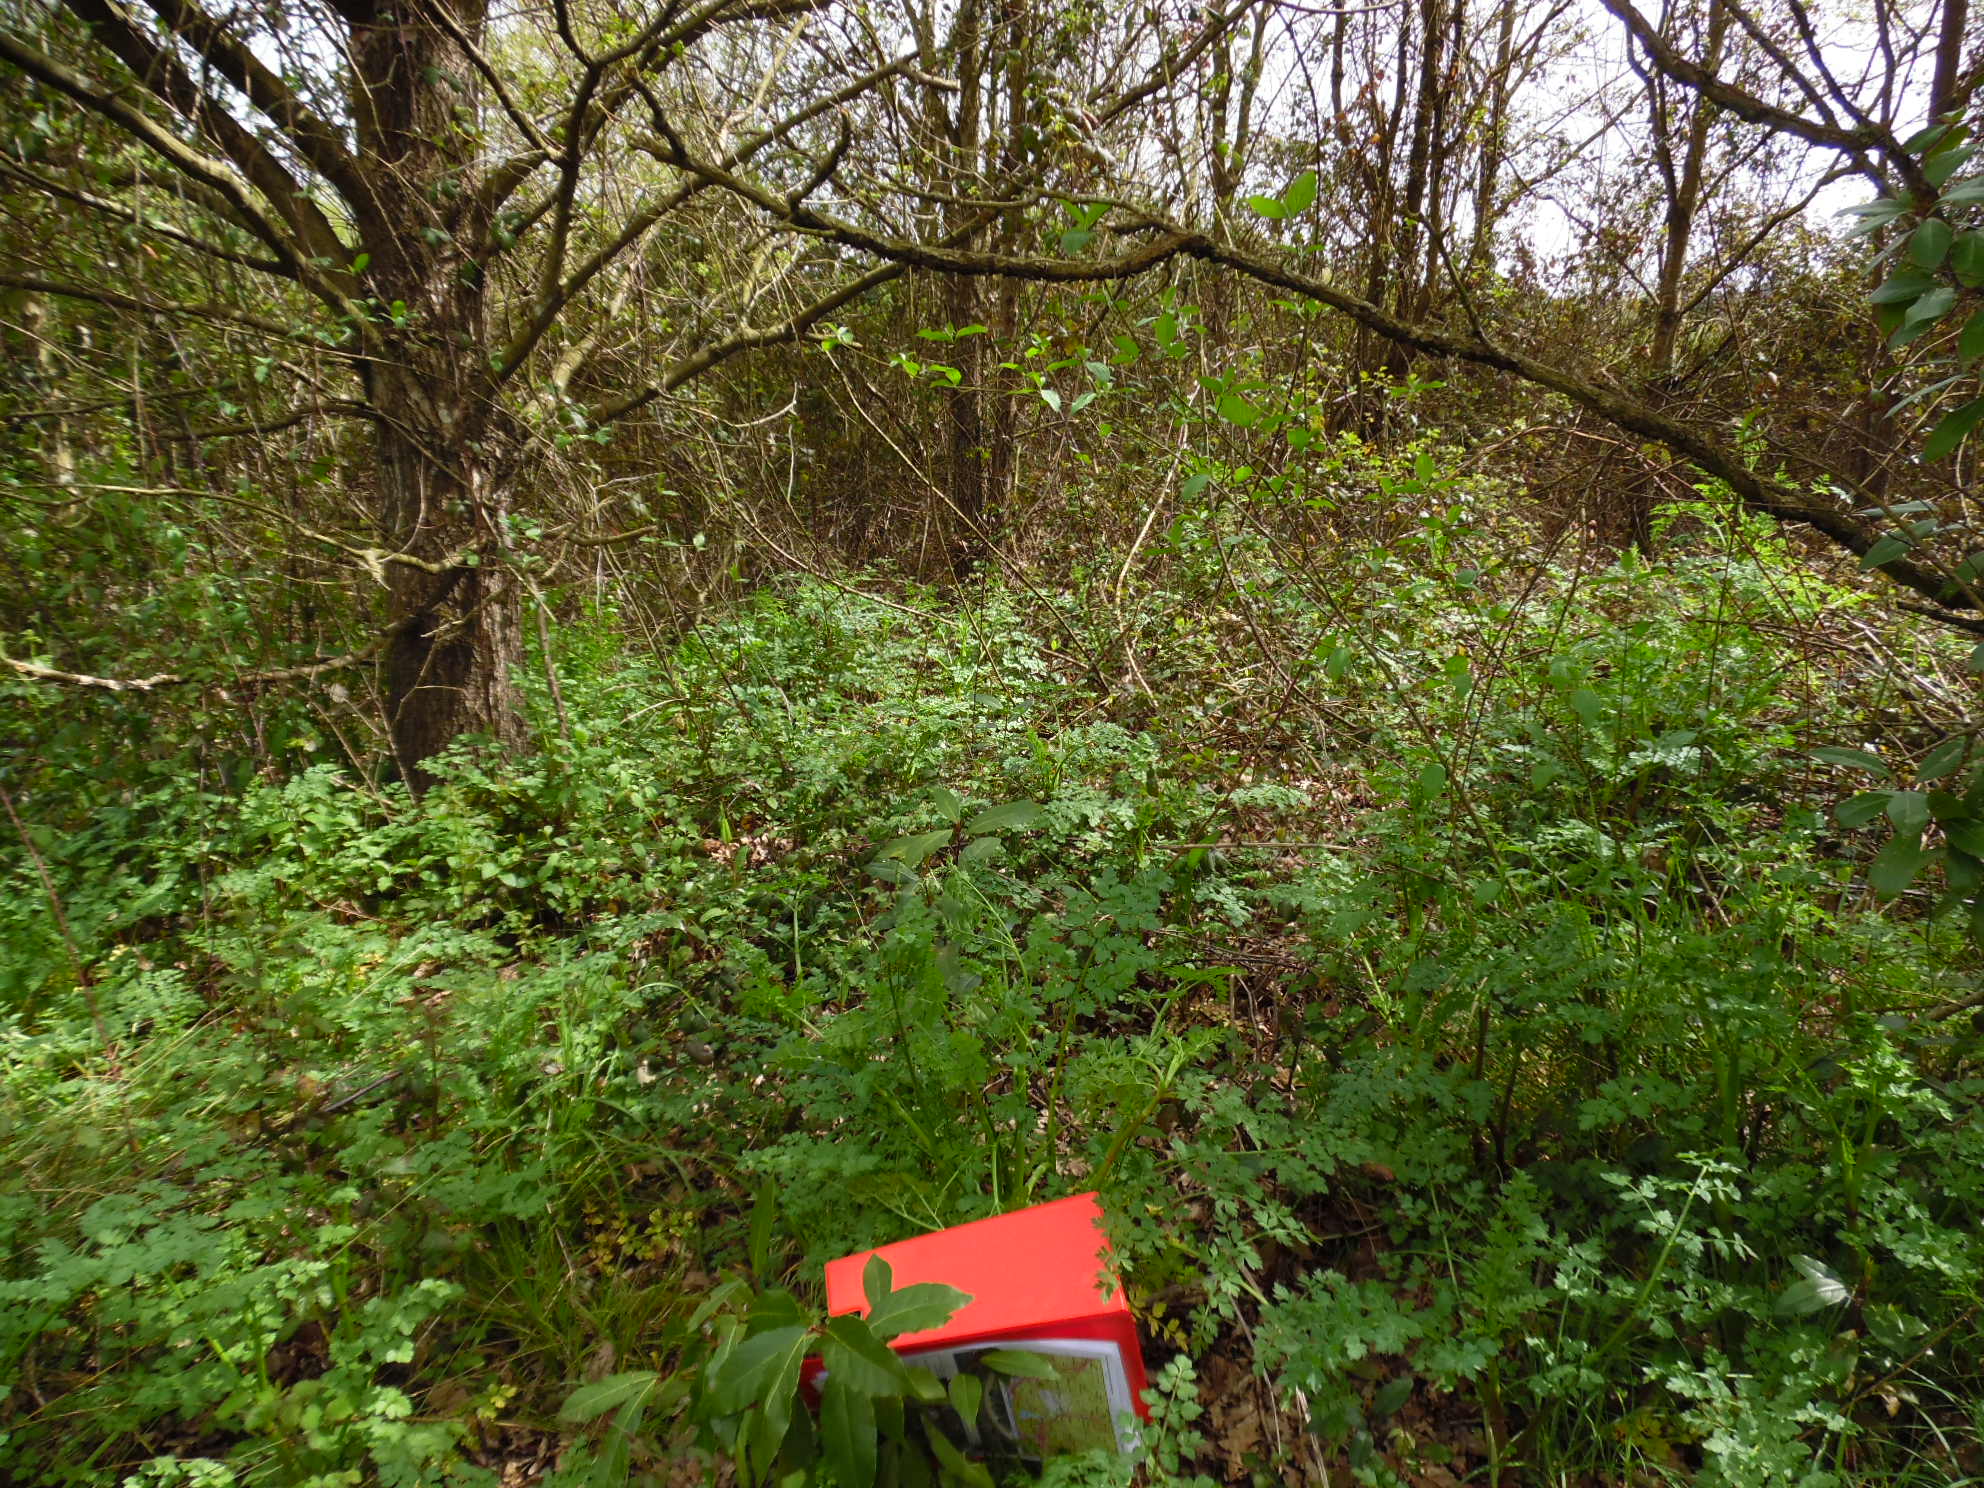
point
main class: Woodland
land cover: Broadleaved woodland
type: floodplain forest
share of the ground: > 75 %
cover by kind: broadleaved forest trees 90 %, shrubs 5 %, herbaceous plants 5 %
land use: Semi-natural and natural areas not in use
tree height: > 5 m
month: April
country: ES
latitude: 43.5245
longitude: -5.8648
